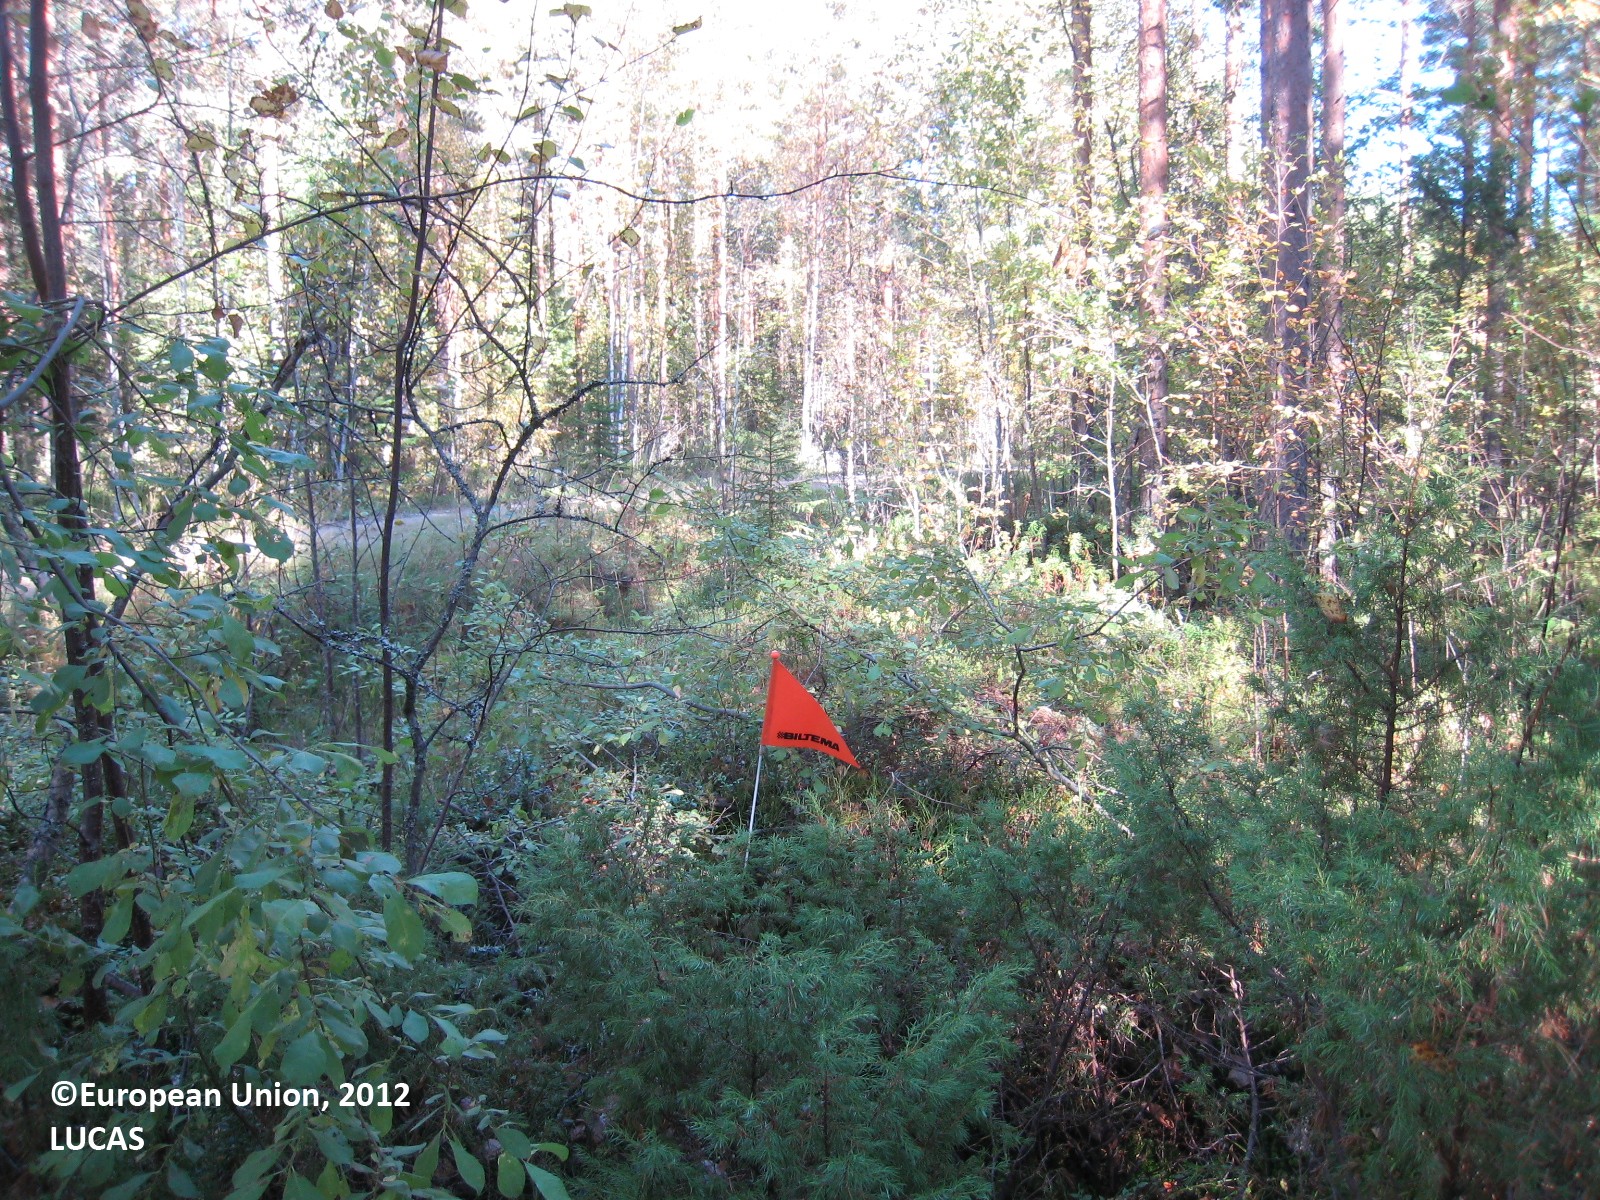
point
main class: Woodland
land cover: Pine dominated mixed woodland
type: boreal forest
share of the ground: > 75 %
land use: Forestry
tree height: > 5 m
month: September
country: FI
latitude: 62.8453
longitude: 26.6149
